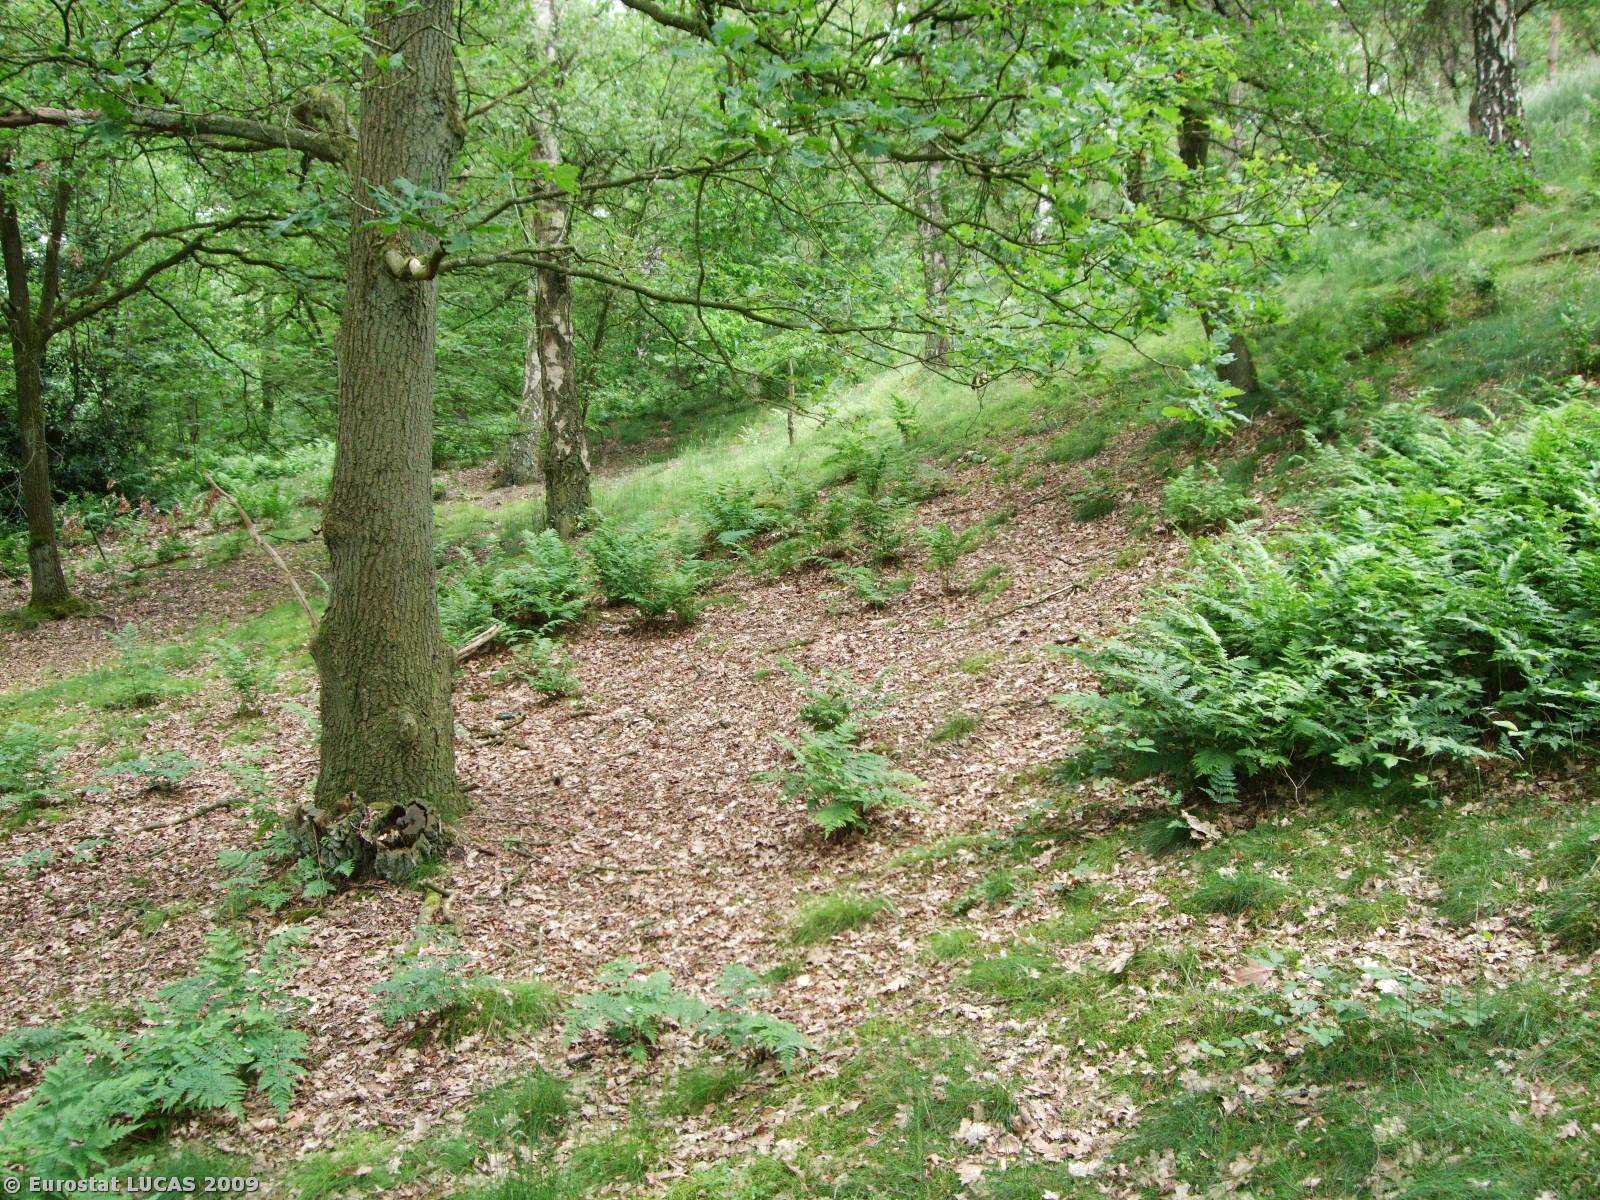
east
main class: Woodland
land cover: Mixed woodland
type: mesophytic deciduous forest
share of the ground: > 75 %
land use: Nature reserves
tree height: > 5 m
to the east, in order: Mixed woodland; Tracks; Mixed woodland
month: May
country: NL
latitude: 51.5063
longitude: 6.1812
